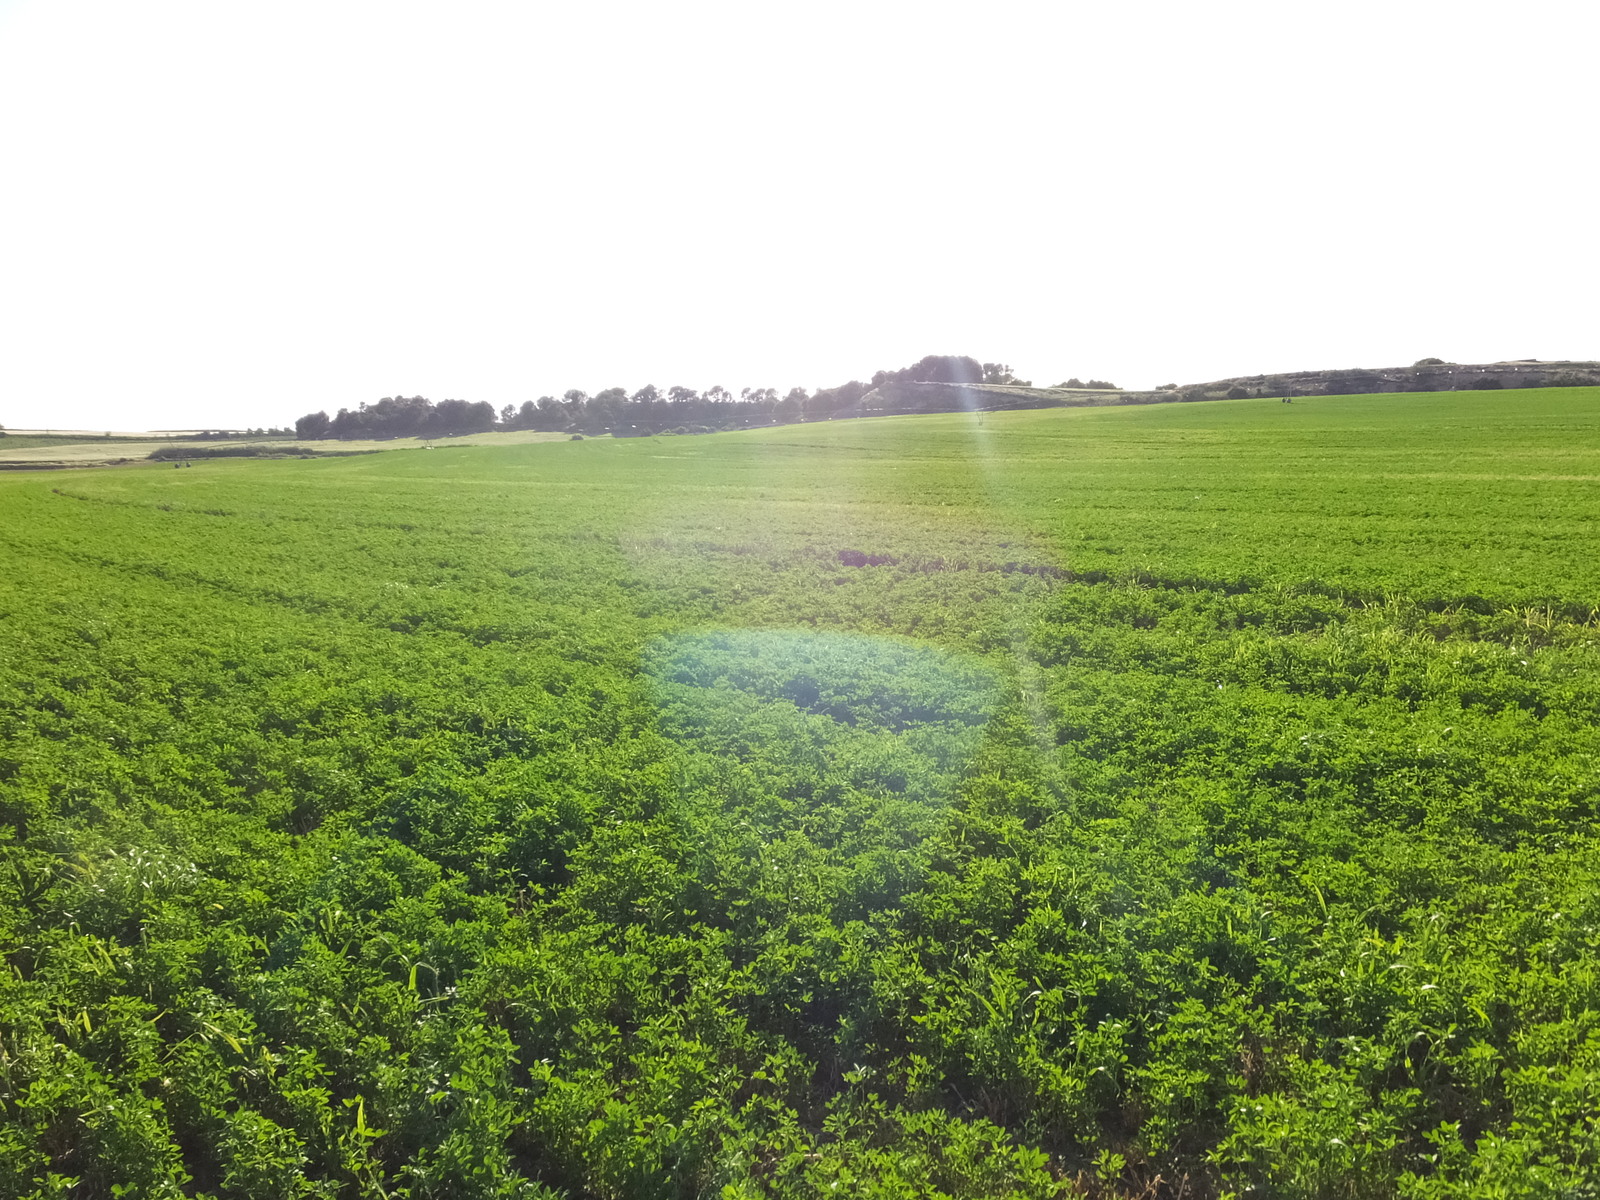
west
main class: Cropland
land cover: Lucerne
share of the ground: > 75 %
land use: Agriculture (excluding fallow land and kitchen gardens)
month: May
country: ES
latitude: 41.6353
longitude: 0.4190
